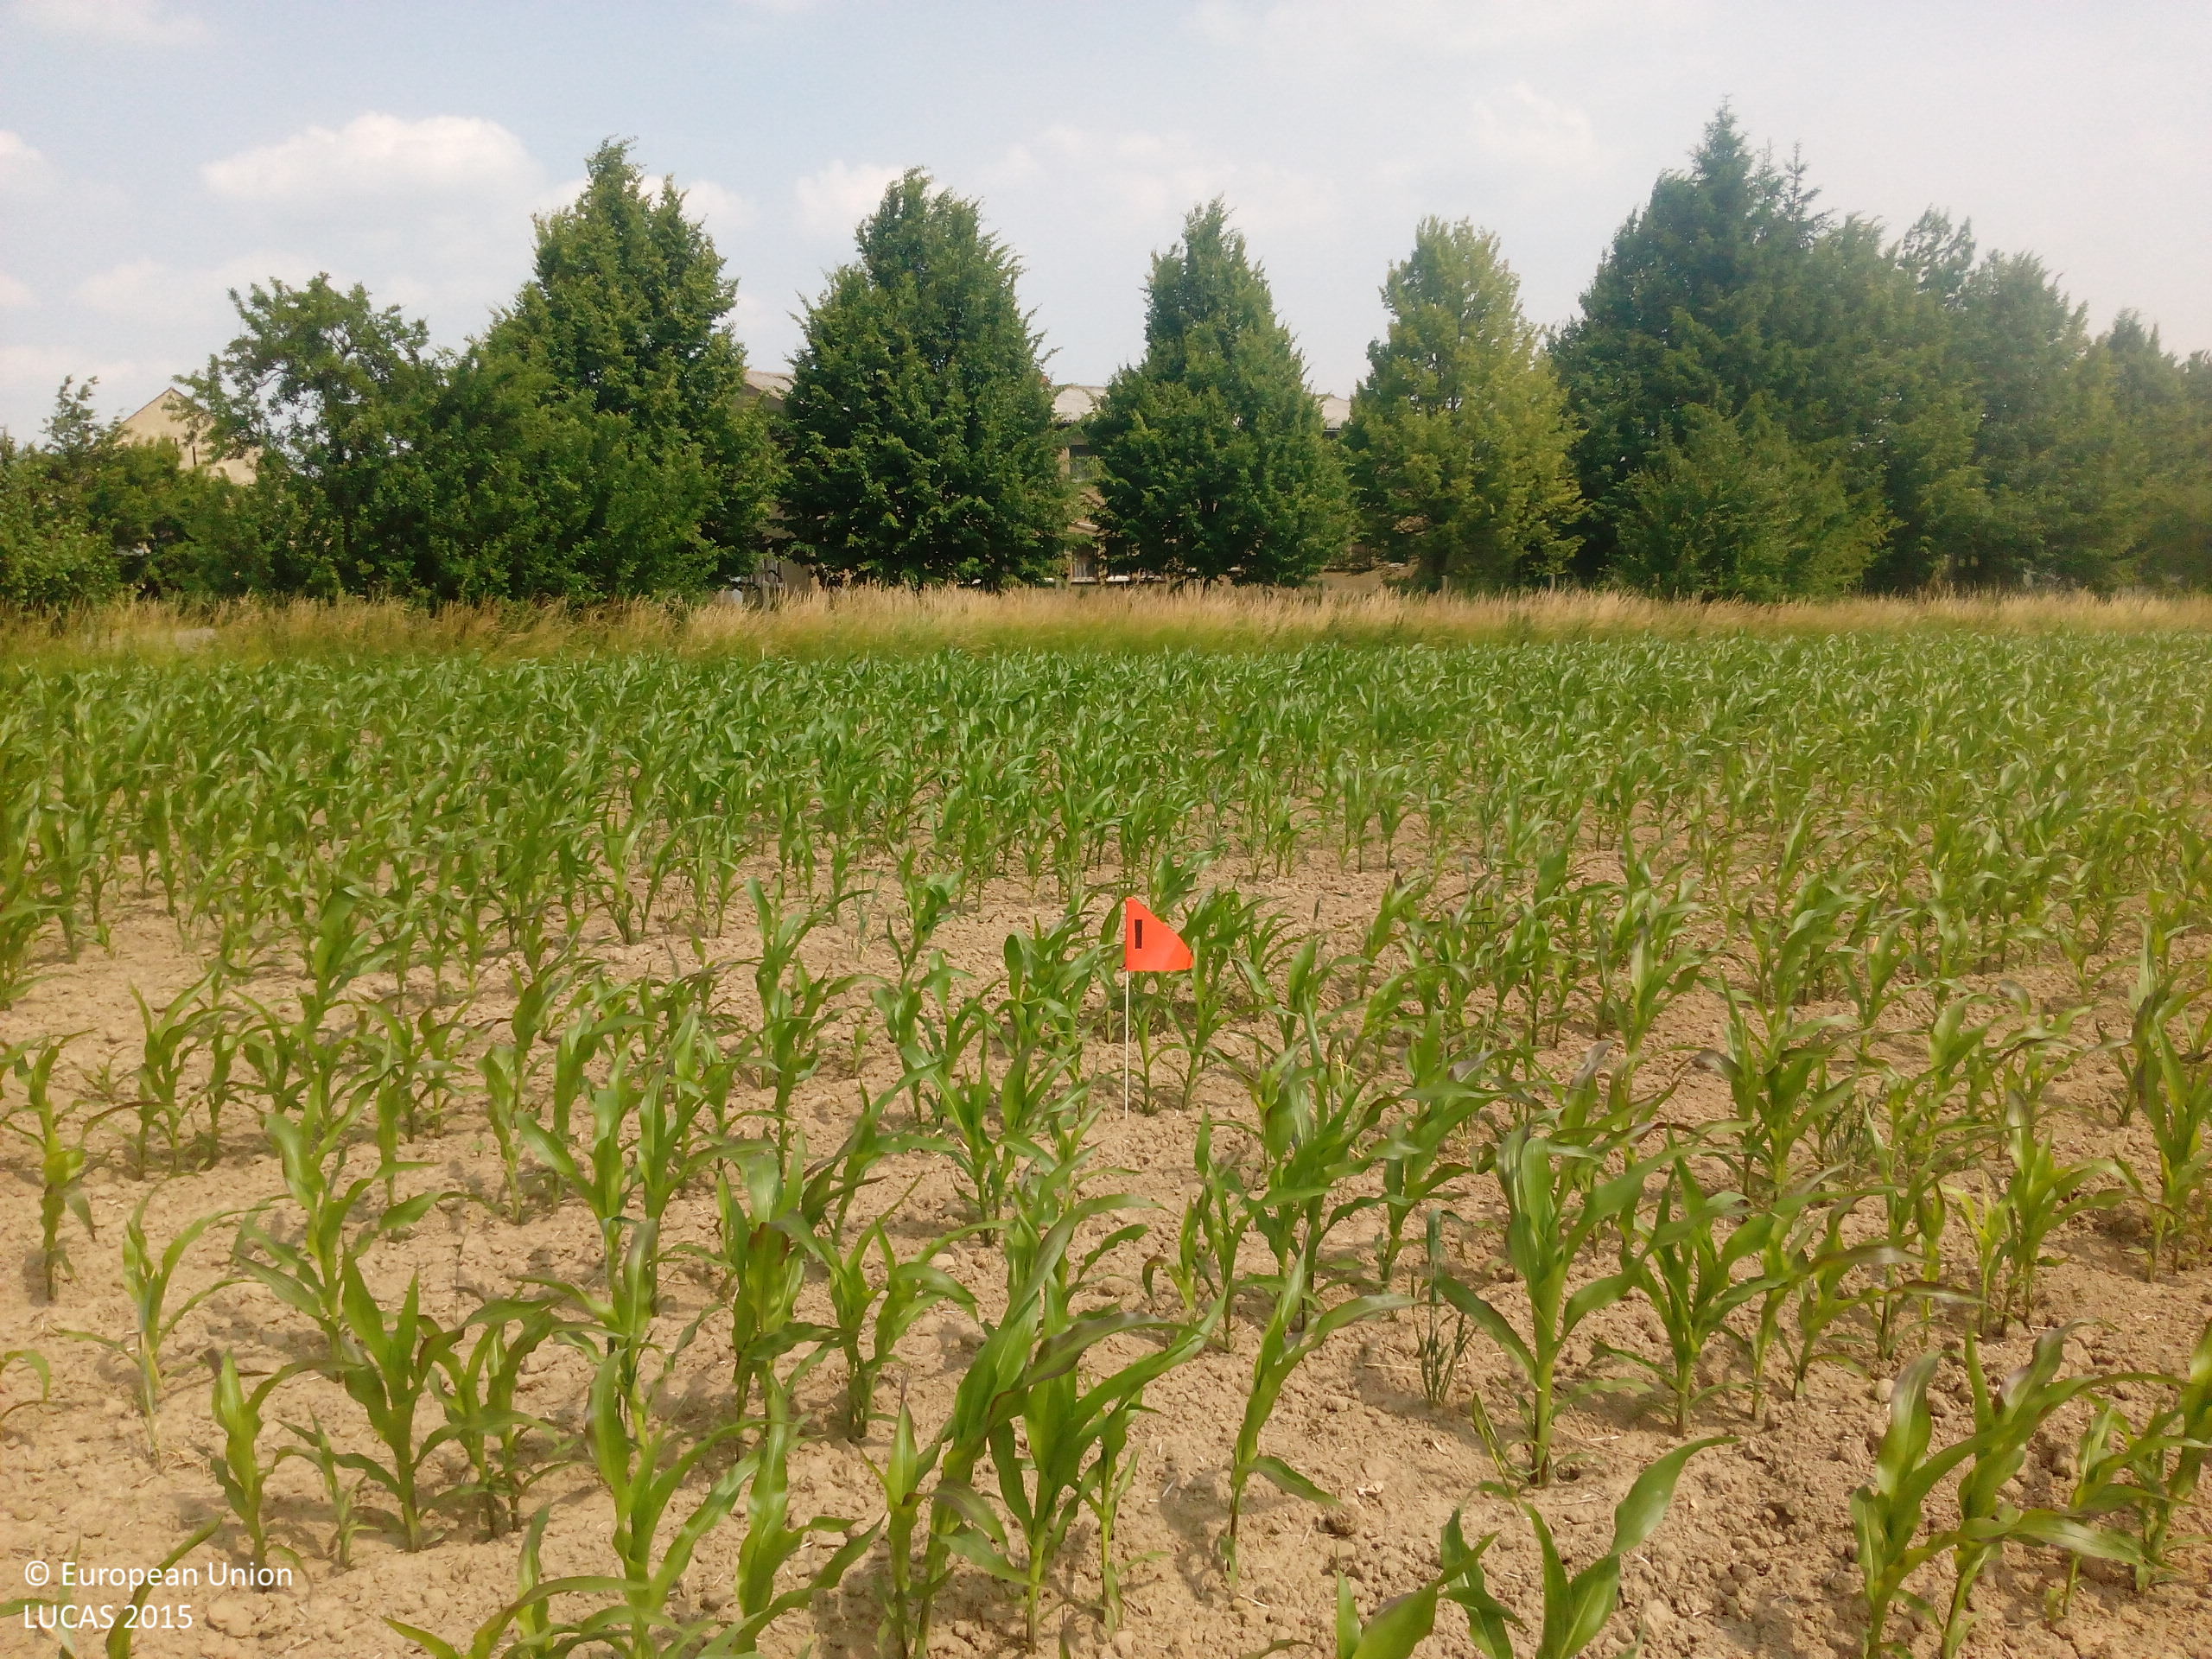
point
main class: Cropland
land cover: Maize
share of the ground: 25 - 50 %
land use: Agriculture (excluding fallow land and kitchen gardens)
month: June
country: DE
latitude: 52.1744
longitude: 11.1256
